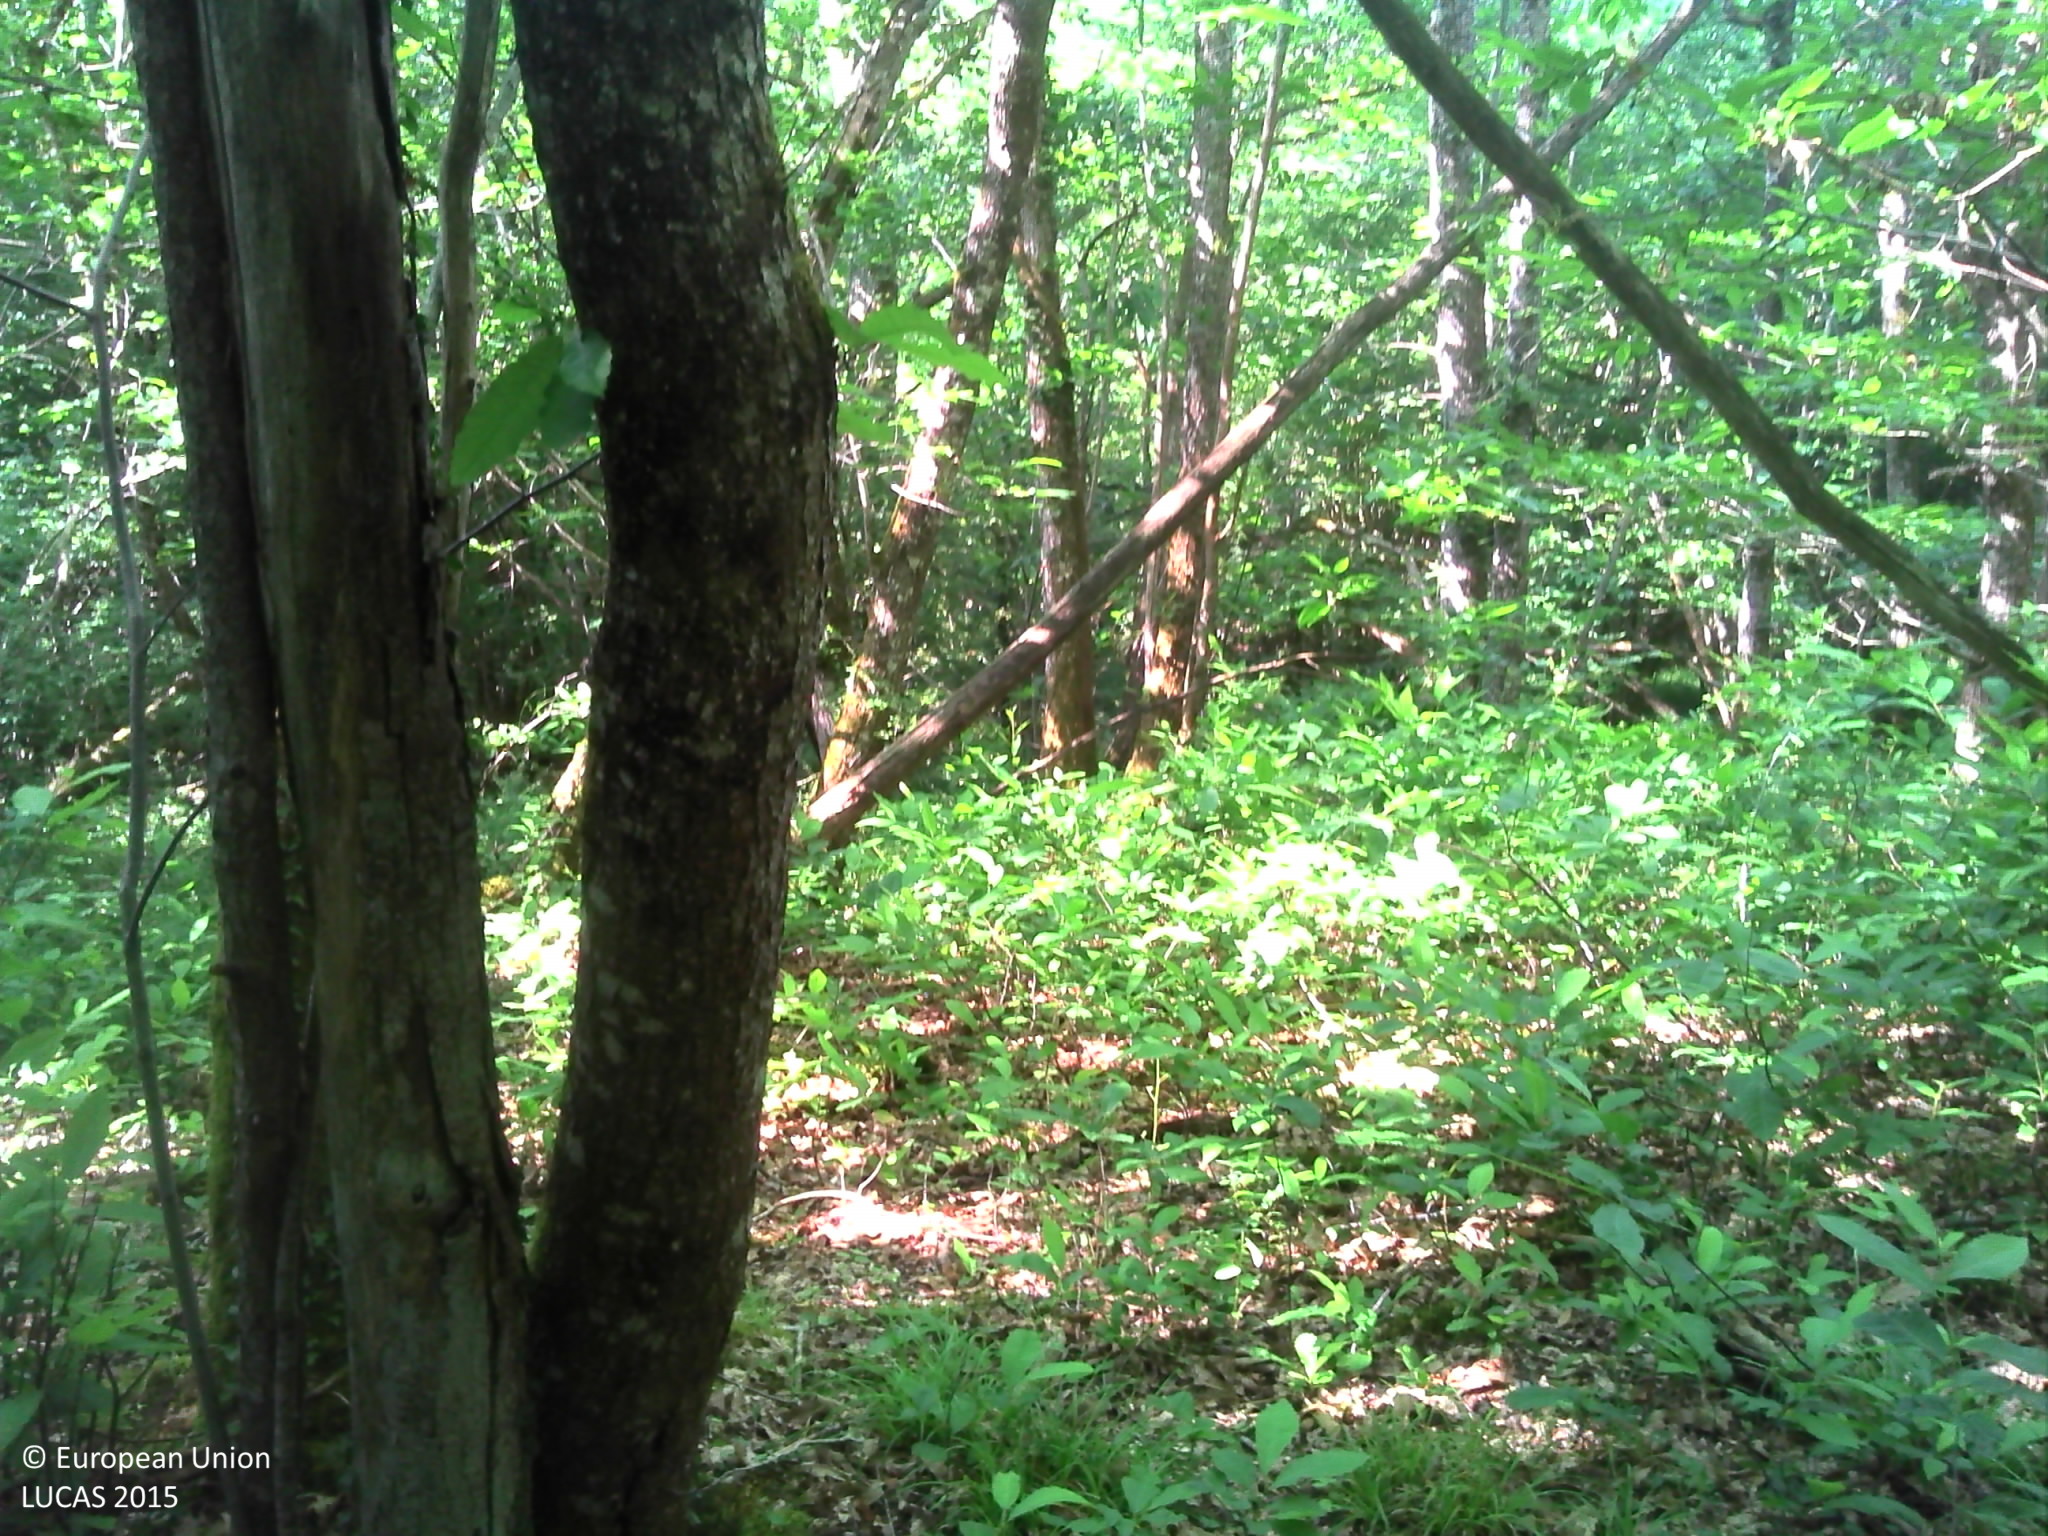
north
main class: Woodland
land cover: Broadleaved woodland
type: mesophytic deciduous forest
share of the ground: > 75 %
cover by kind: broadleaved forest trees 75 %, shrubs 10 %, herbaceous plants 10 %, lichens and mosses 5 %
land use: Forestry
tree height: > 5 m
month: June
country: FR
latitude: 47.5282
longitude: 0.7761
